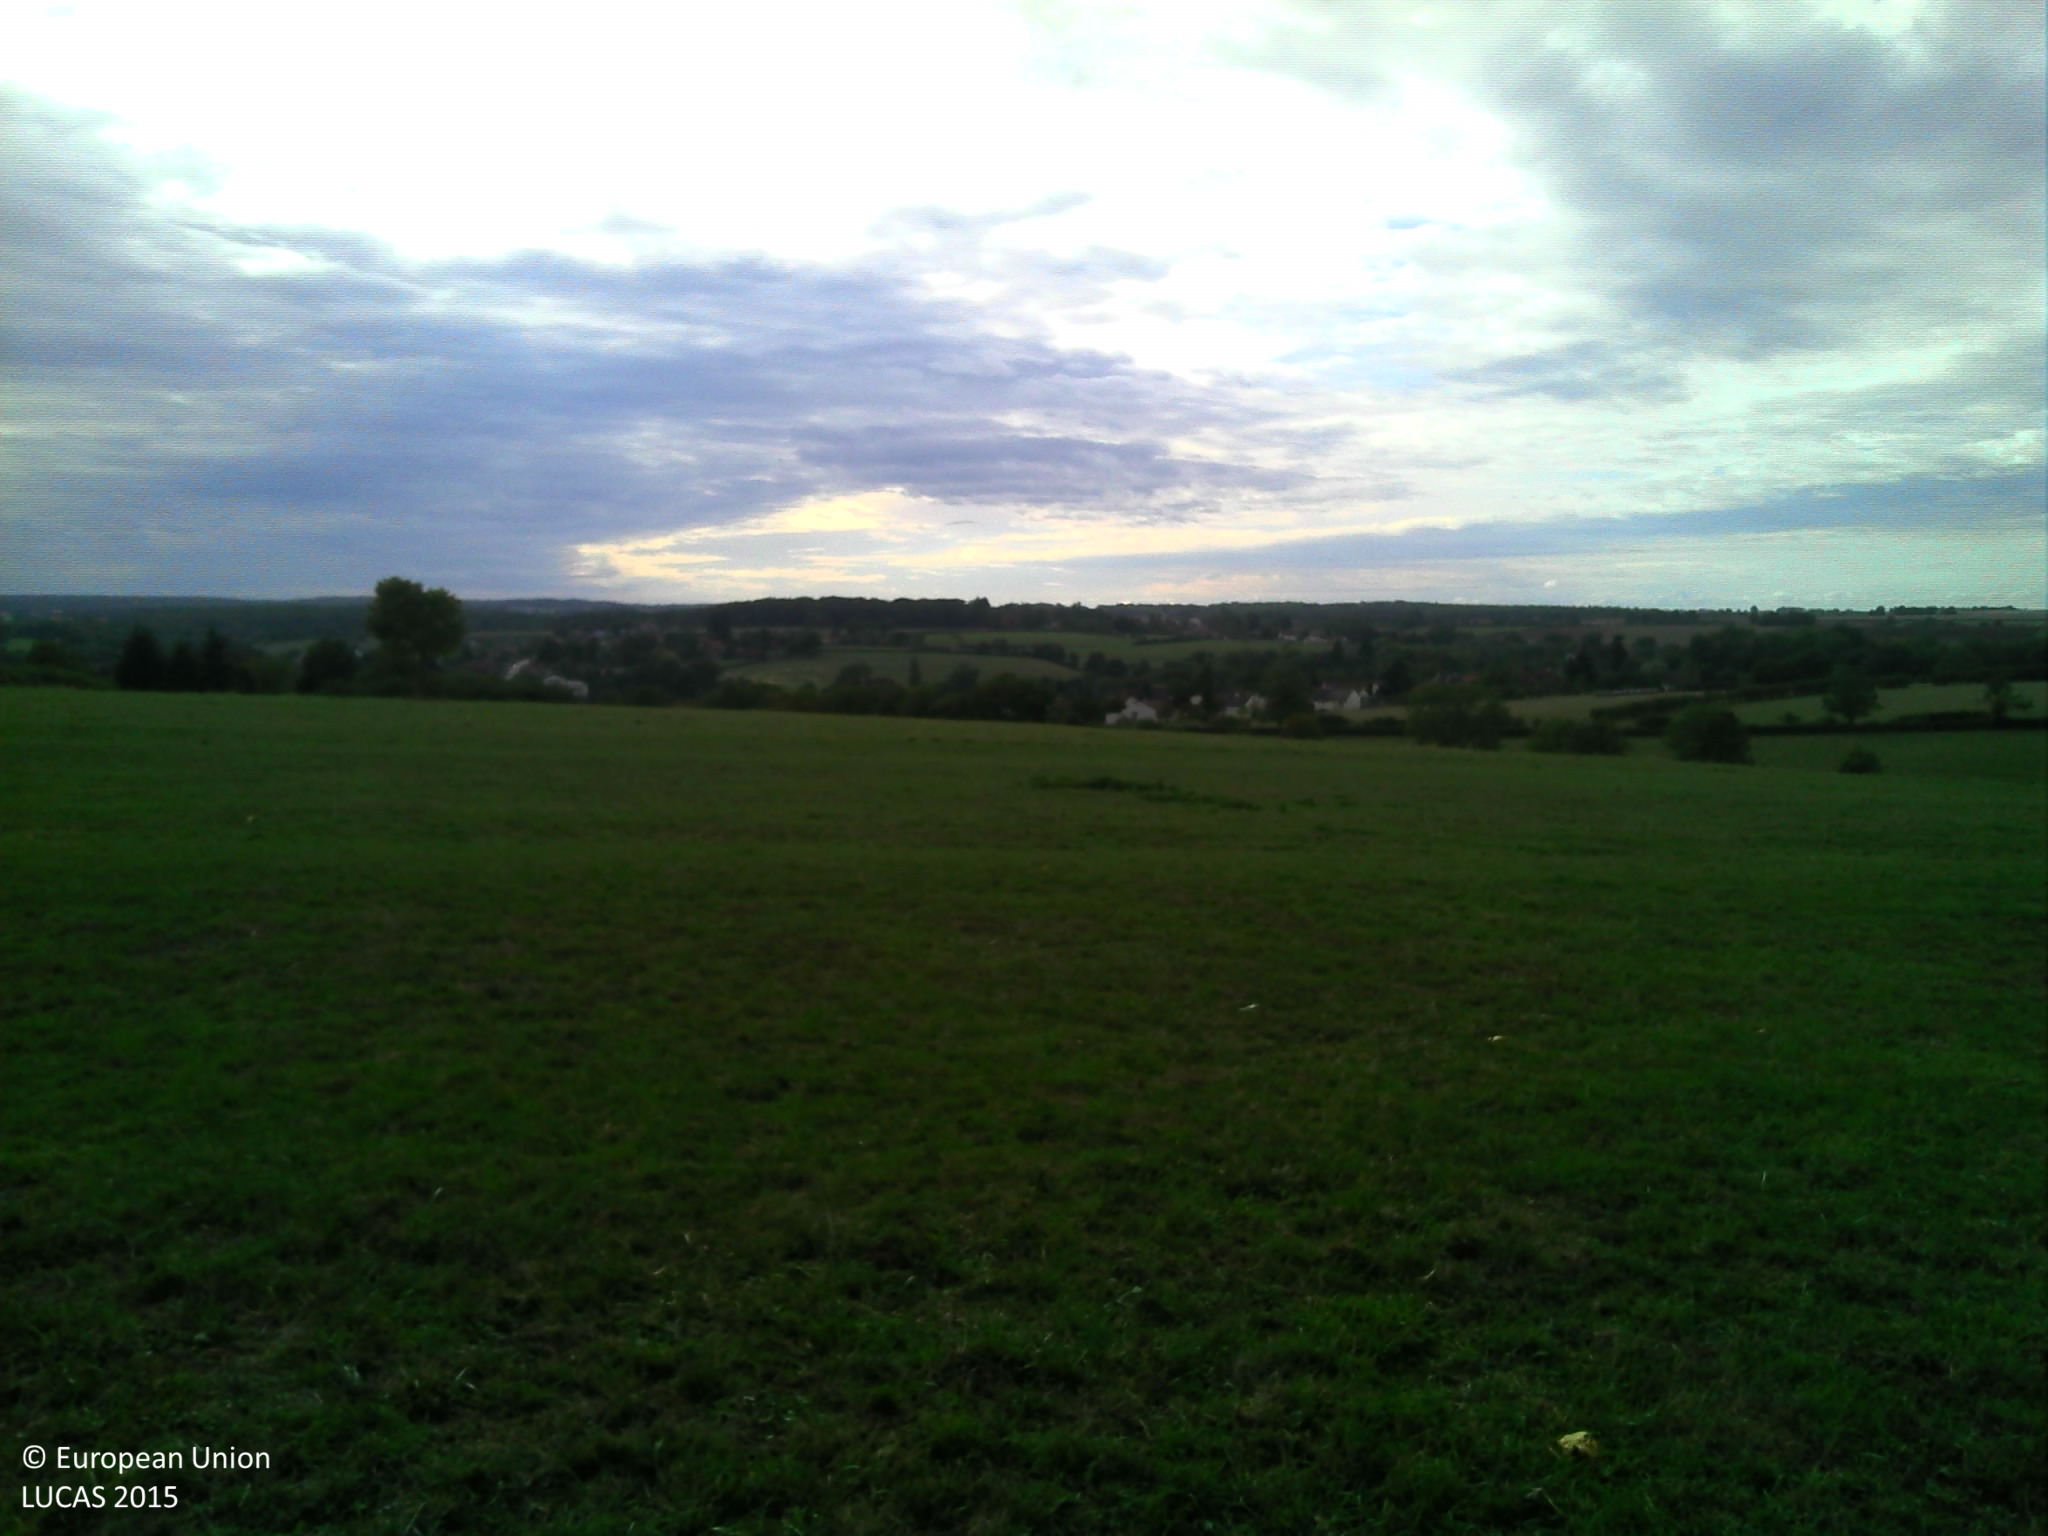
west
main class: Grassland
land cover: Grassland without tree/shrub cover
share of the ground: > 75 %
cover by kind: herbaceous plants 100 %
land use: Agriculture (excluding fallow land and kitchen gardens)
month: September
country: FR
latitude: 47.3913
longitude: 4.3155
